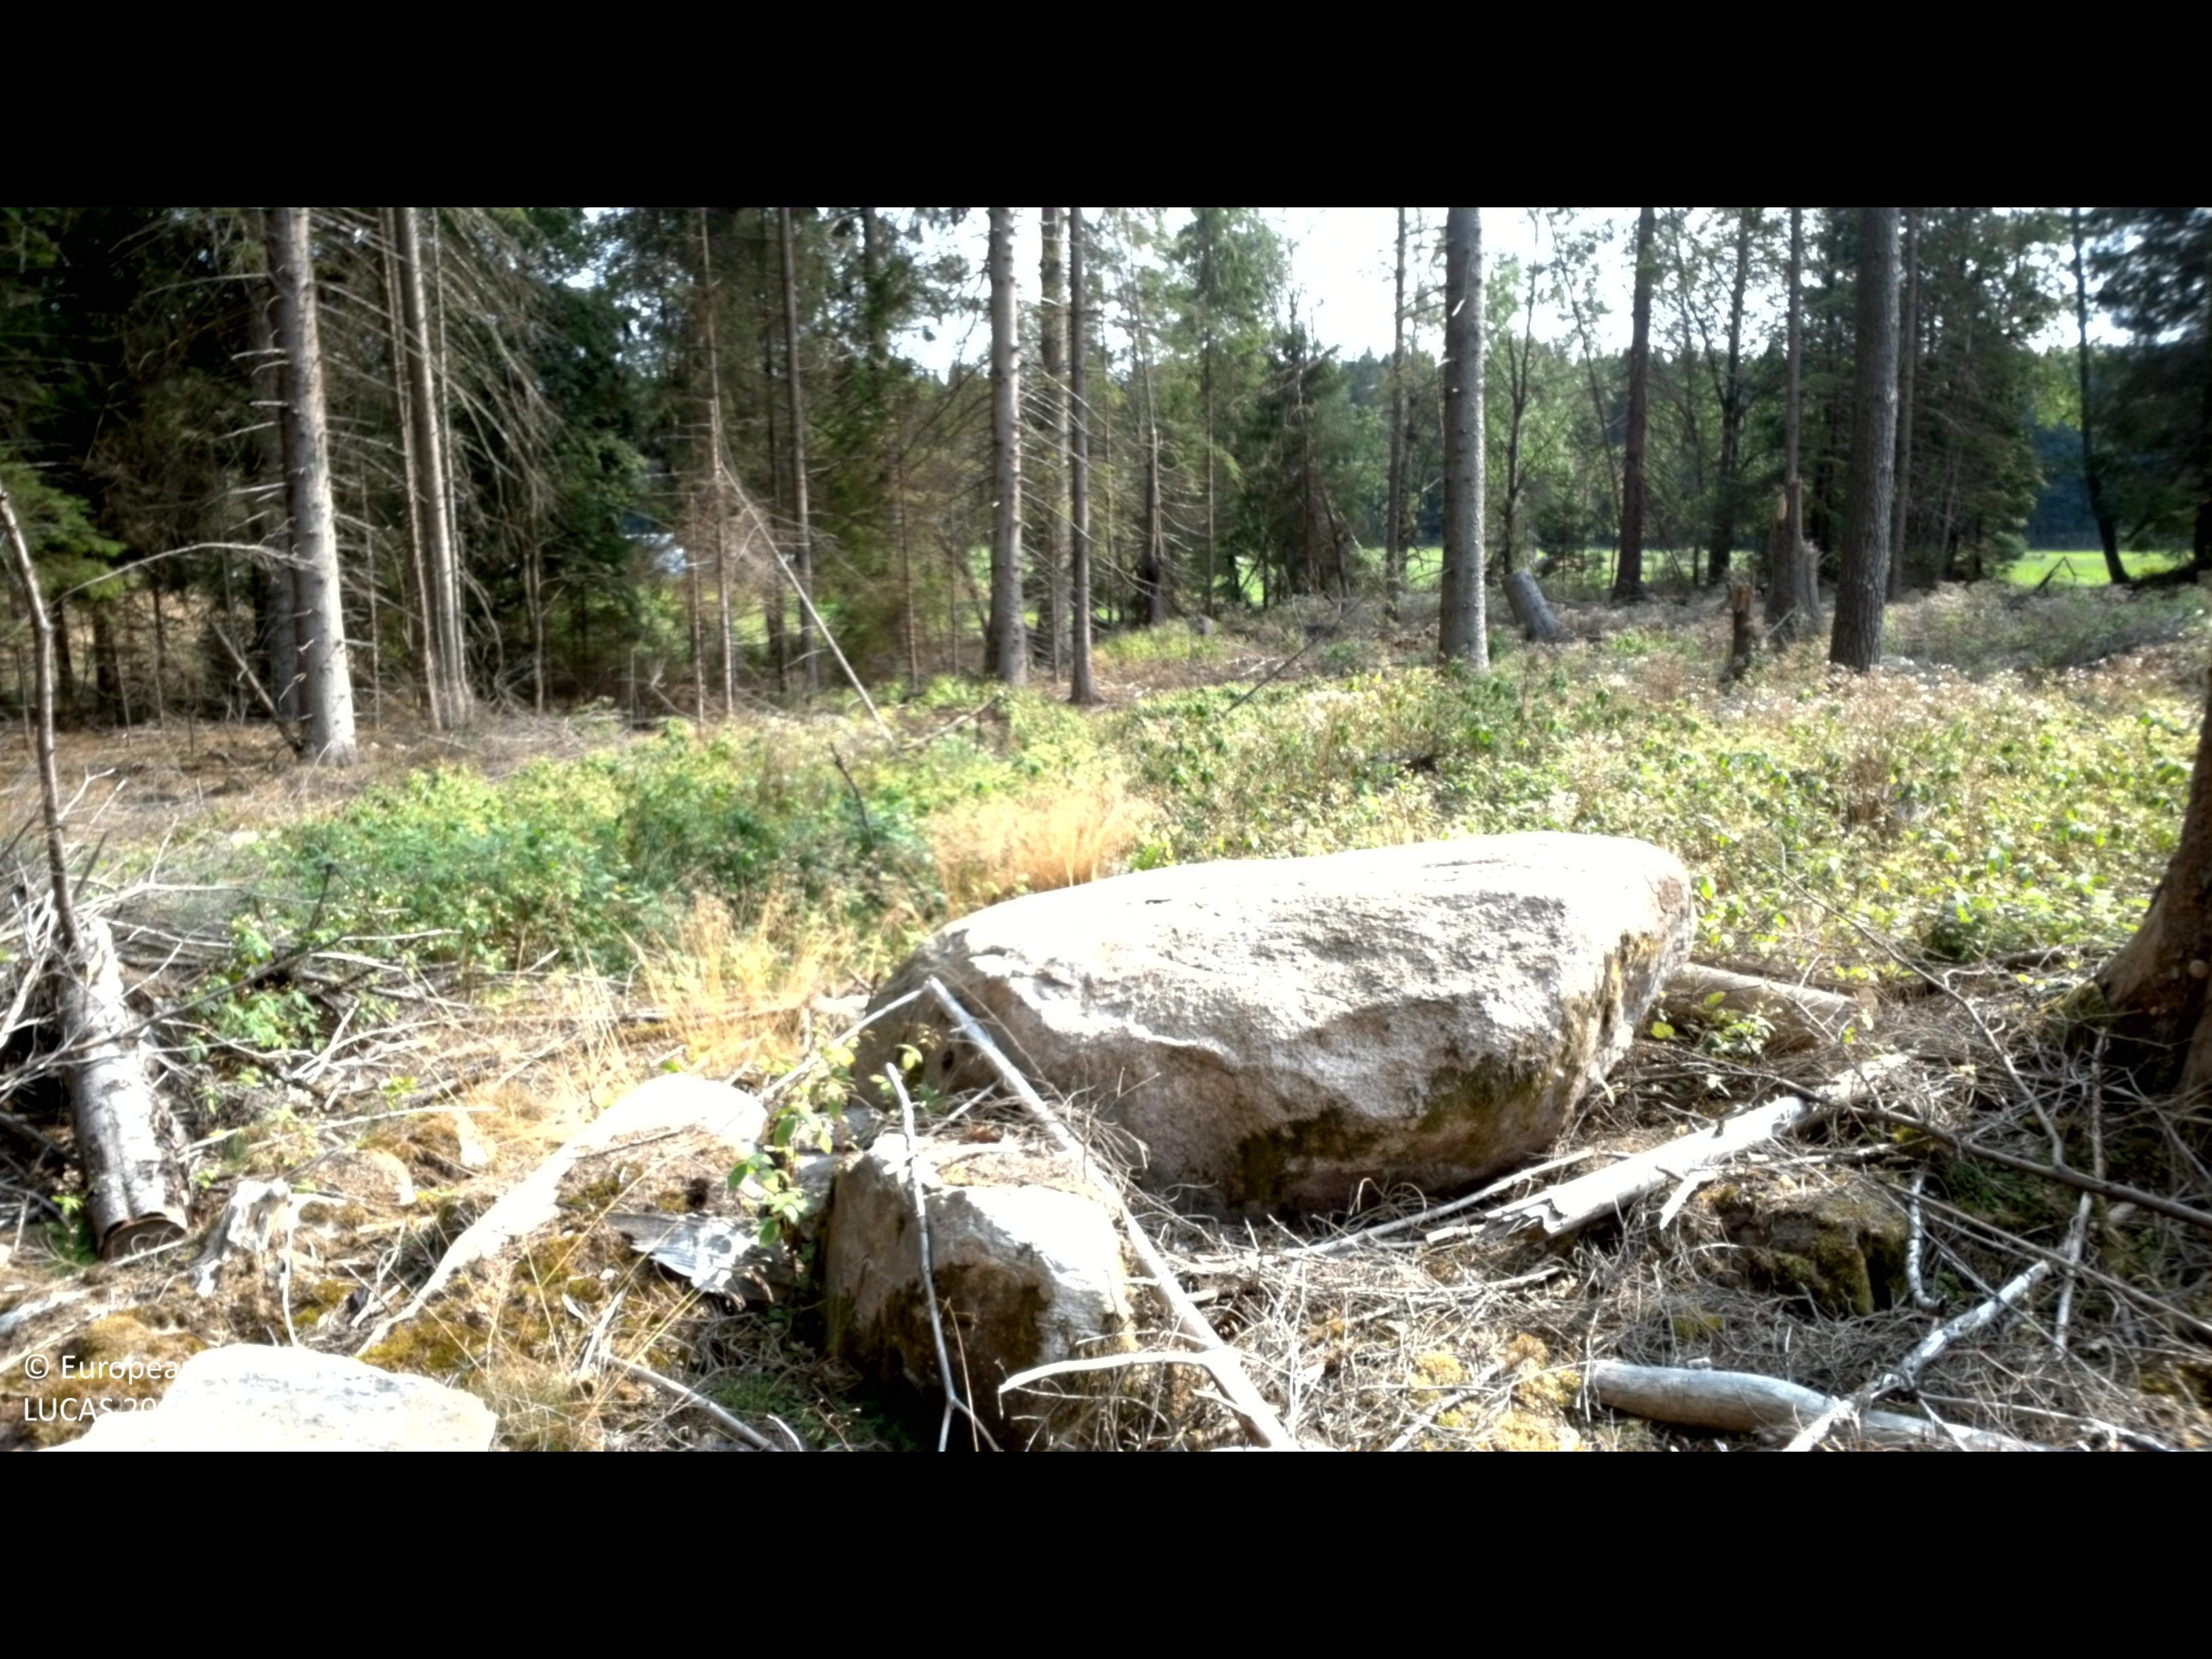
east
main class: Woodland
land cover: Spruce dominated coniferous woodland
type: boreal forest
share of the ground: 25 - 50 %
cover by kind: coniferous forest trees 35 %, herbaceous plants 25 %, shrubs 15 %, lichens and mosses 15 %, consolidated bare surface 5 %
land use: Forestry
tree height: > 5 m
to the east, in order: Spruce dominated coniferous woodland; Ditches and canals; Fences; Grassland without tree/shrub cover; Artificial constructions in urban areas; Grassland without tree/shrub cover; Ditches and canals; Single bushes/trees; Grassland without tree/shrub cover
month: August
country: SE
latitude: 56.2838
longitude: 14.1166
